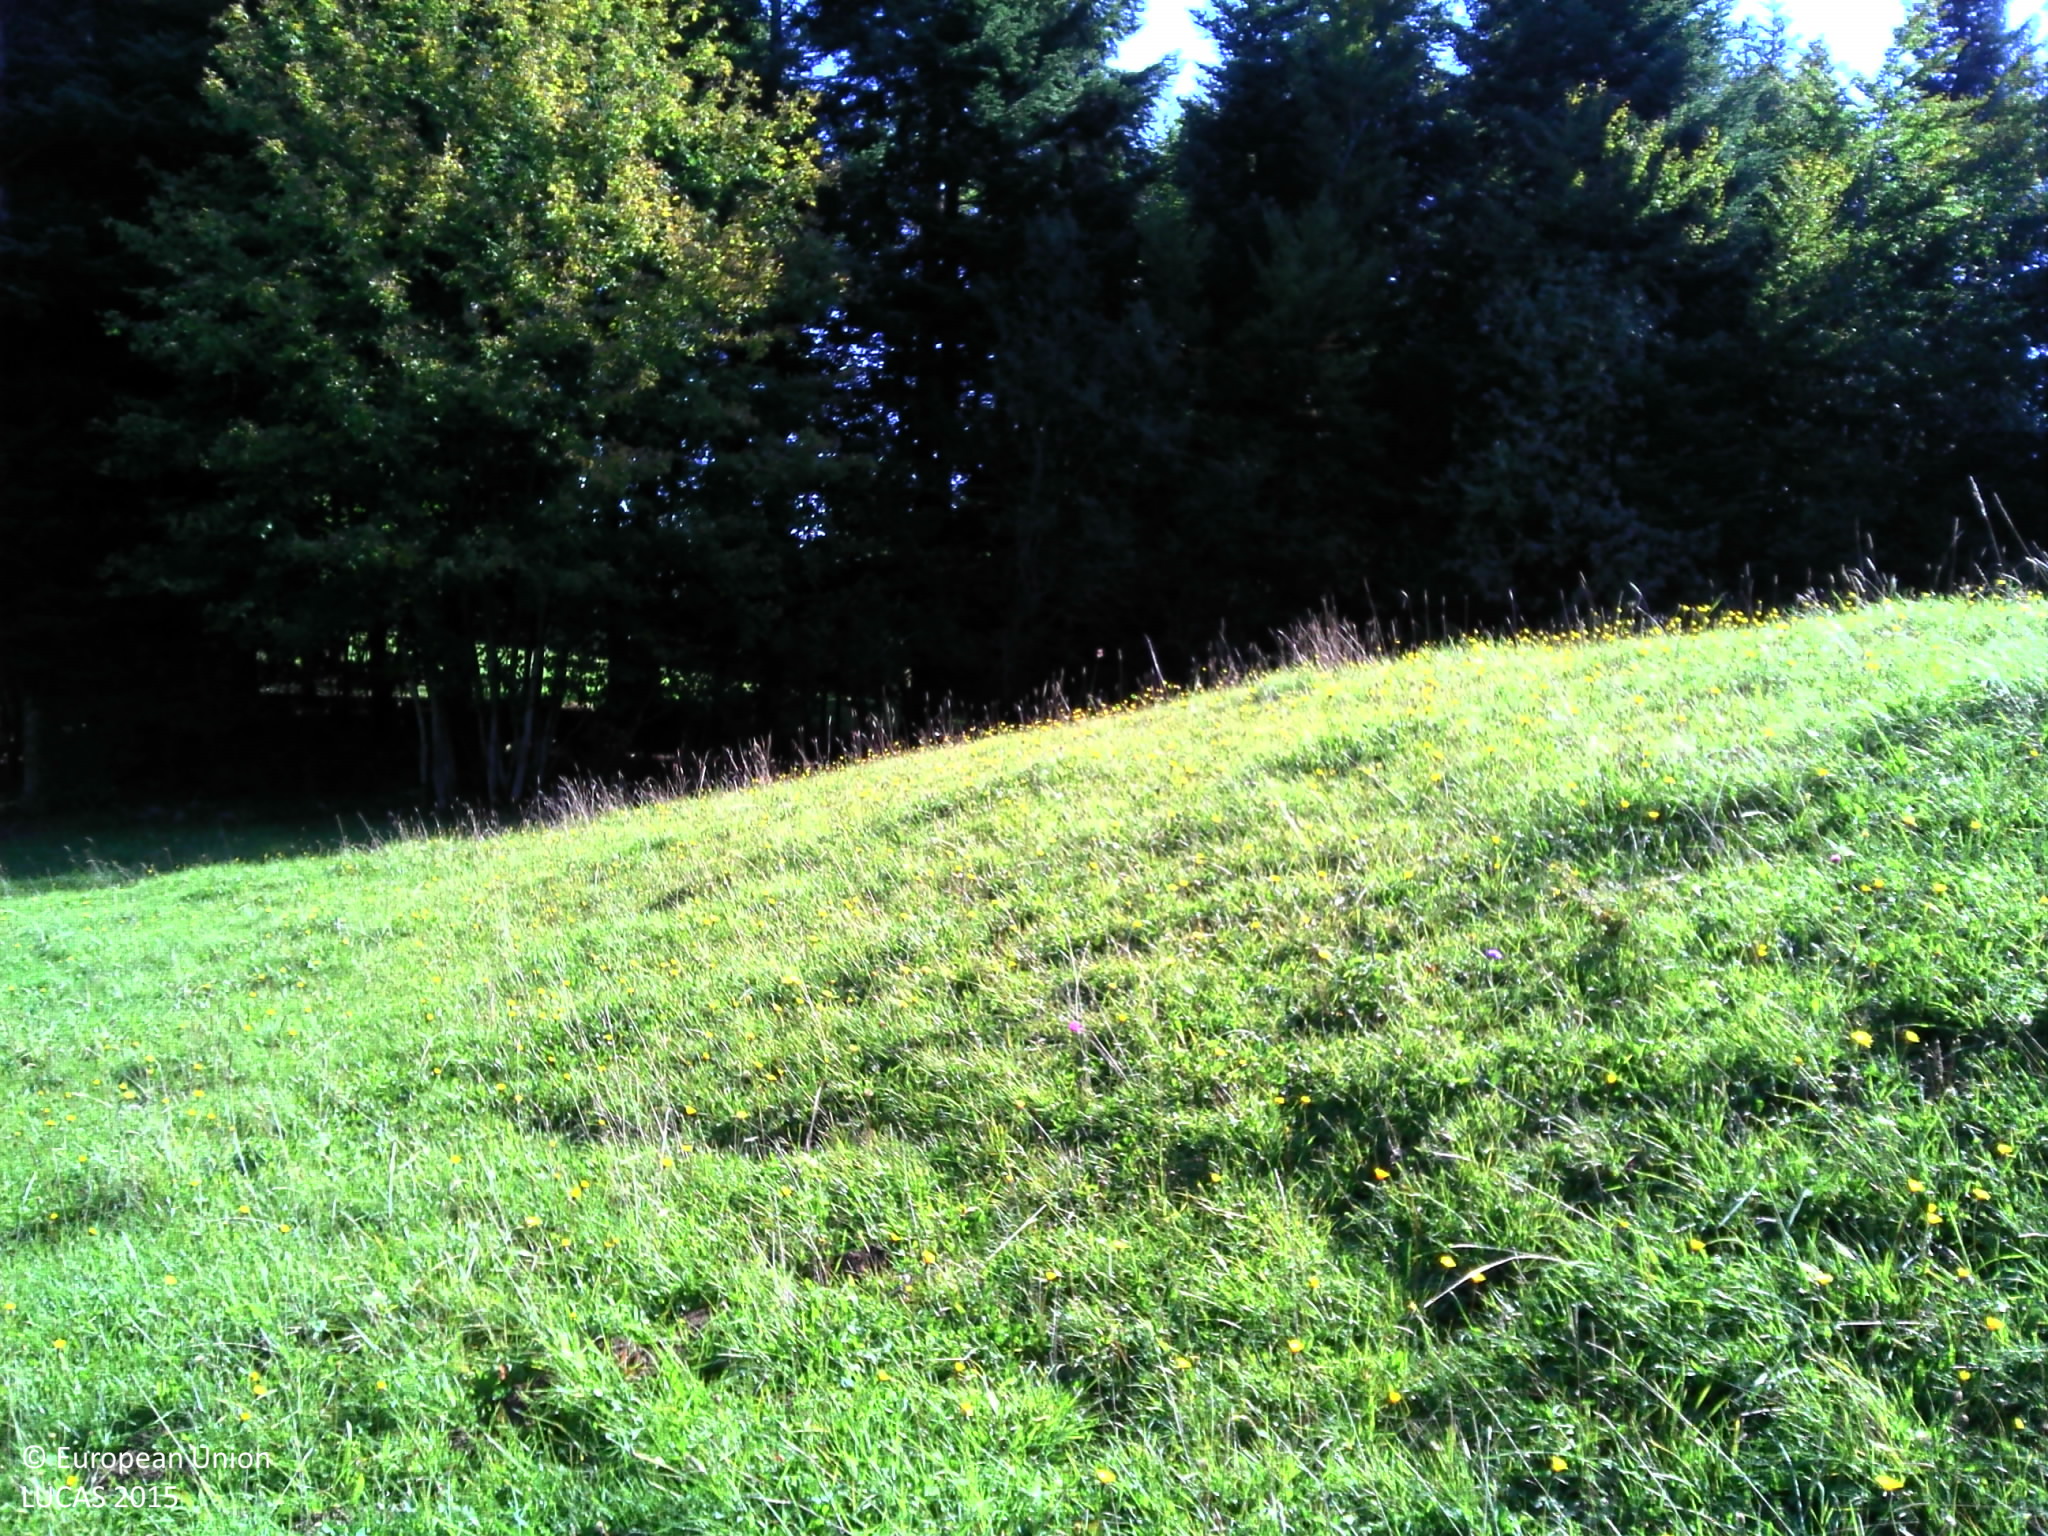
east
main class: Grassland
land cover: Grassland without tree/shrub cover
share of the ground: > 75 %
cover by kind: herbaceous plants 100 %
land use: Agriculture (excluding fallow land and kitchen gardens)
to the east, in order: Grassland without tree/shrub cover; Spruce dominated mixed woodland; Grassland without tree/shrub cover; Spruce dominated mixed woodland; Fences; Grassland without tree/shrub cover; Tracks; Grassland without tree/shrub cover; Fences; Spruce dominated mixed woodland; Fences; Grassland without tree/shrub cover
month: September
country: FR
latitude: 47.0831
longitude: 6.3800
